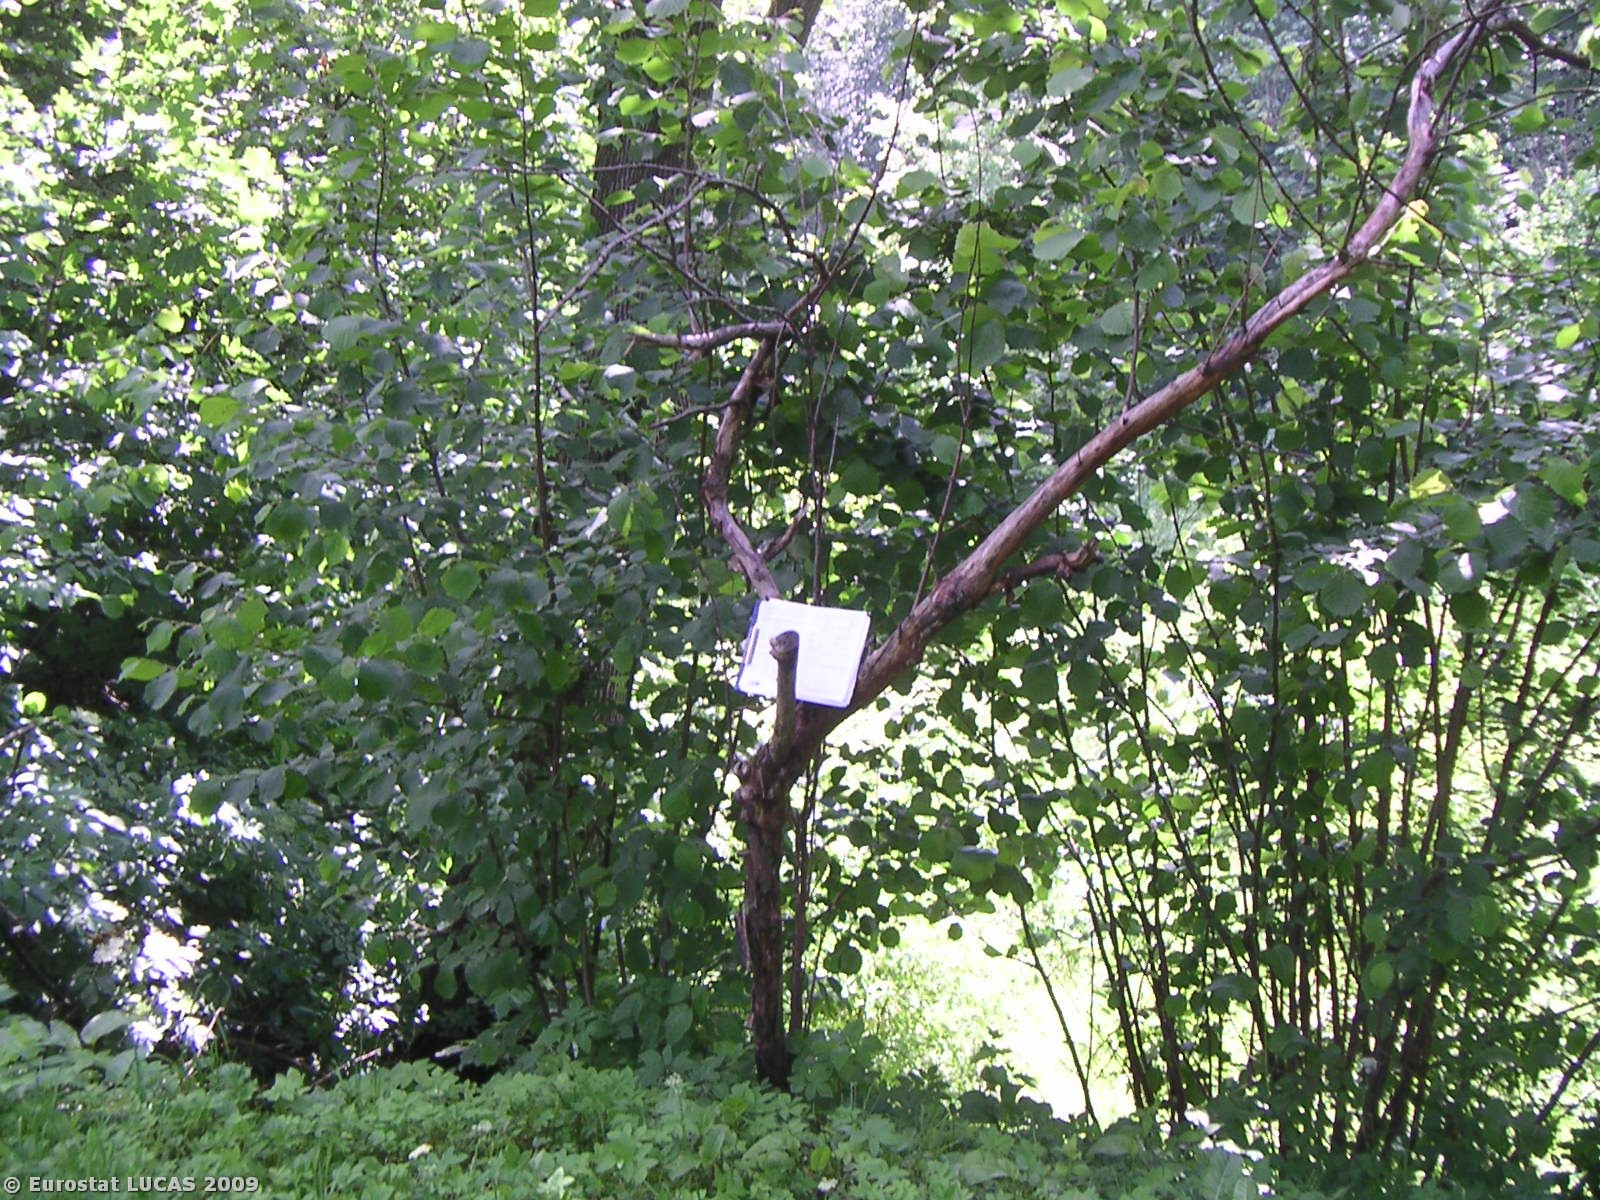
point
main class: Shrubland
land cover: Shrubland with sparse tree cover
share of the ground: > 75 %
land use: Unused
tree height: > 5 m
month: June
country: PL
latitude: 50.1881
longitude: 19.6792
